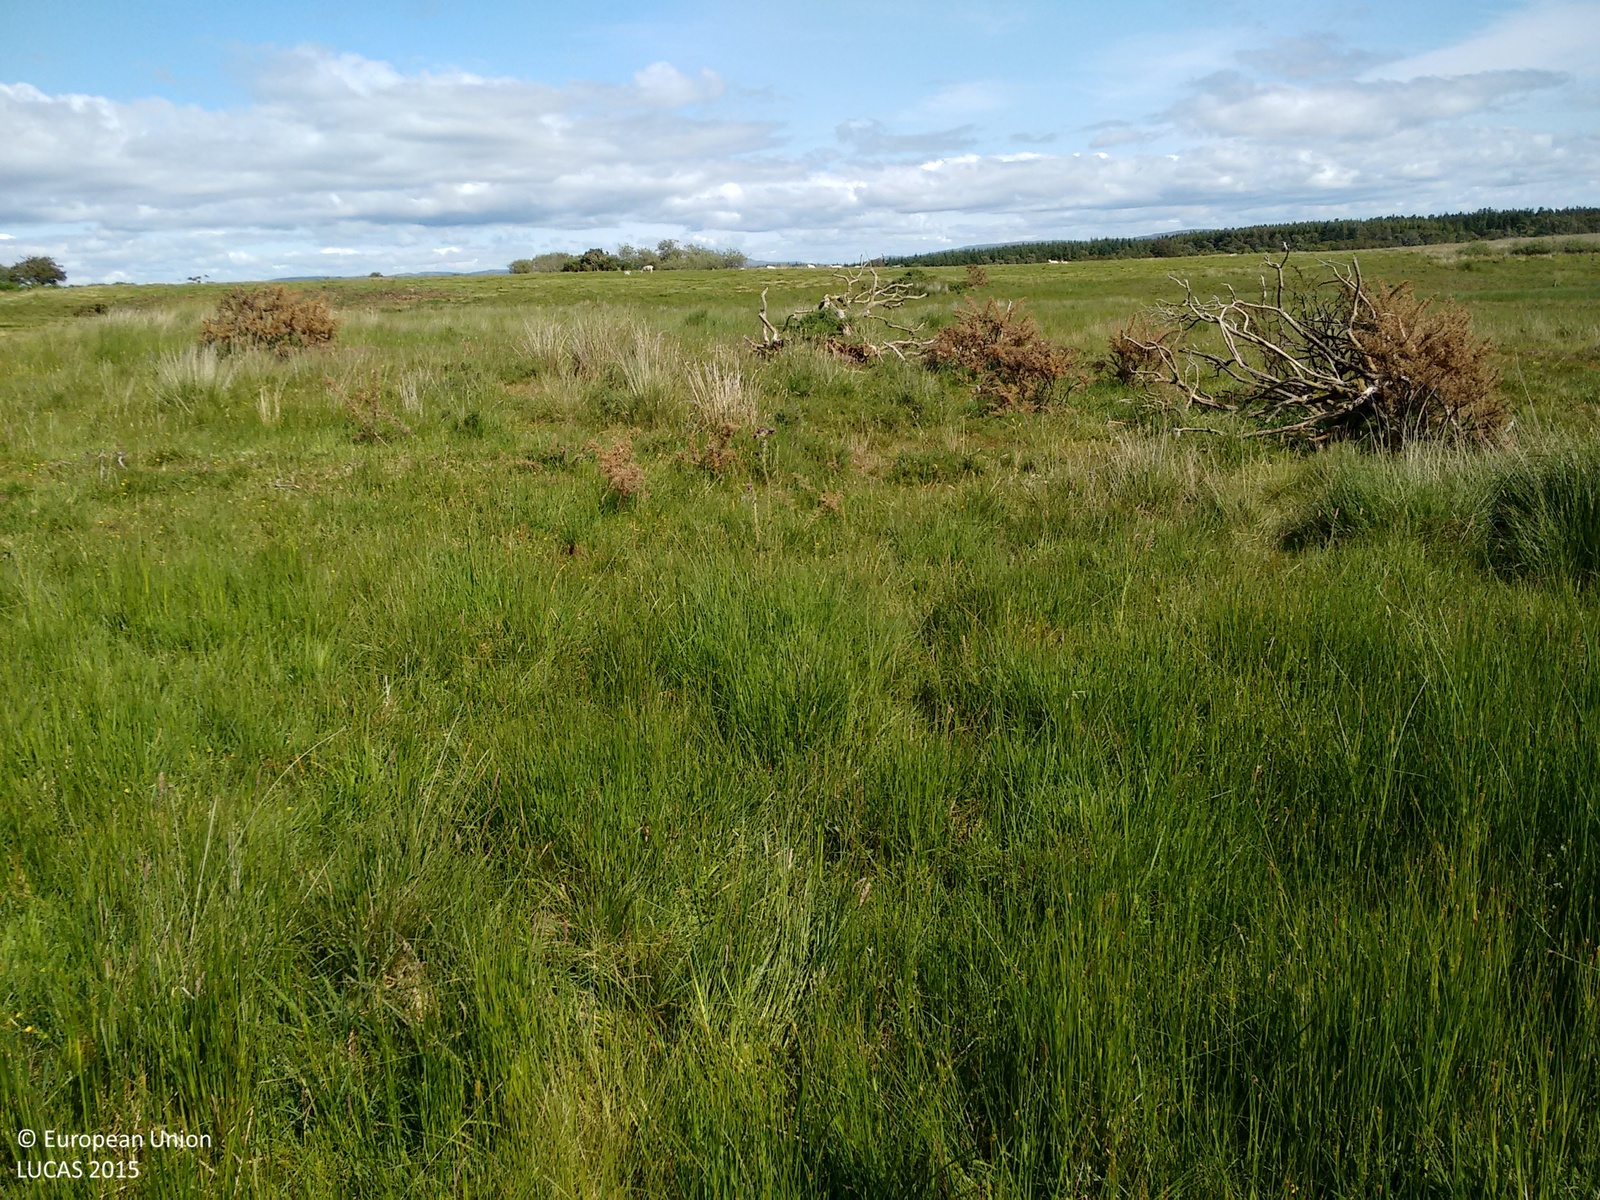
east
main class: Grassland
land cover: Grassland without tree/shrub cover
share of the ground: > 75 %
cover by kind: herbaceous plants 70 %, lichens and mosses 30 %
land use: Agriculture (excluding fallow land and kitchen gardens)
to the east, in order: Grassland without tree/shrub cover; Peatbogs; Grassland without tree/shrub cover
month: July
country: GB
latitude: 55.7871
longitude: -5.0544
